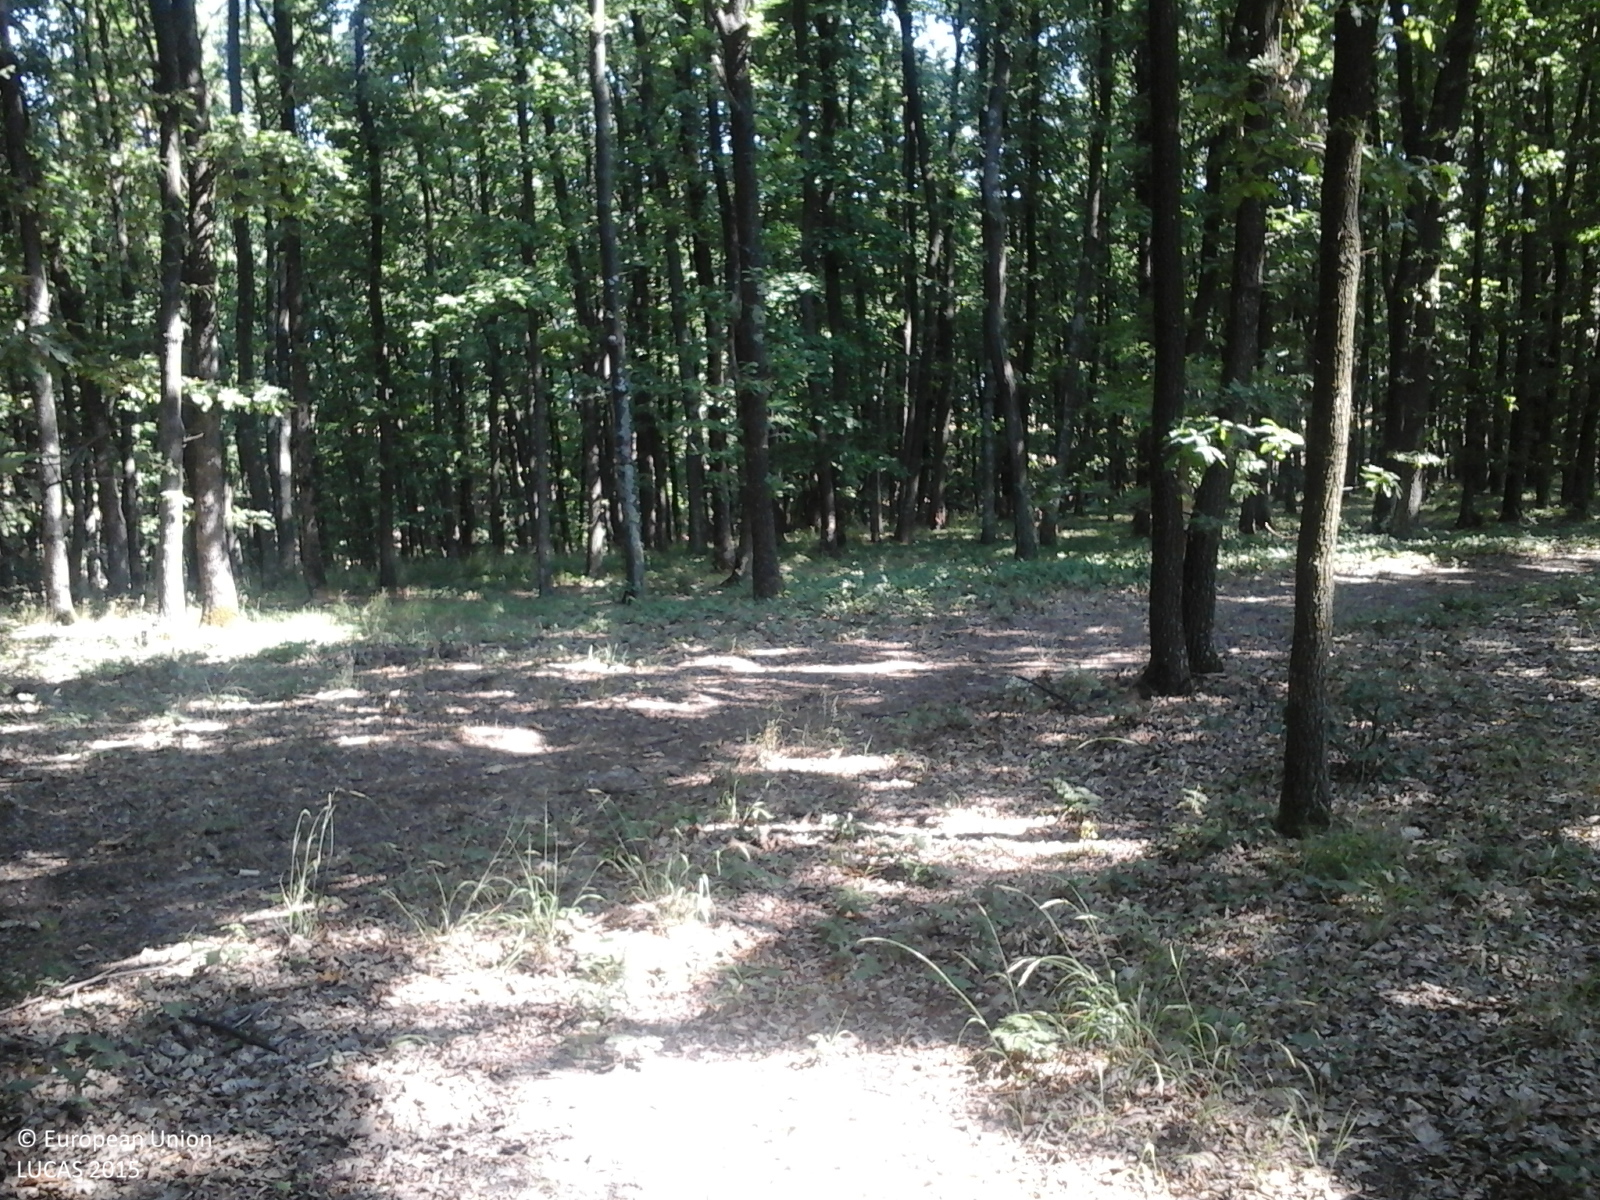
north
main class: Woodland
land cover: Broadleaved woodland
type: acidophilous oak and oak-birch forest
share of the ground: > 75 %
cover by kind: broadleaved forest trees 100 %
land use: Forestry
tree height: > 5 m
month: July
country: RO
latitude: 44.8186
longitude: 24.5546
